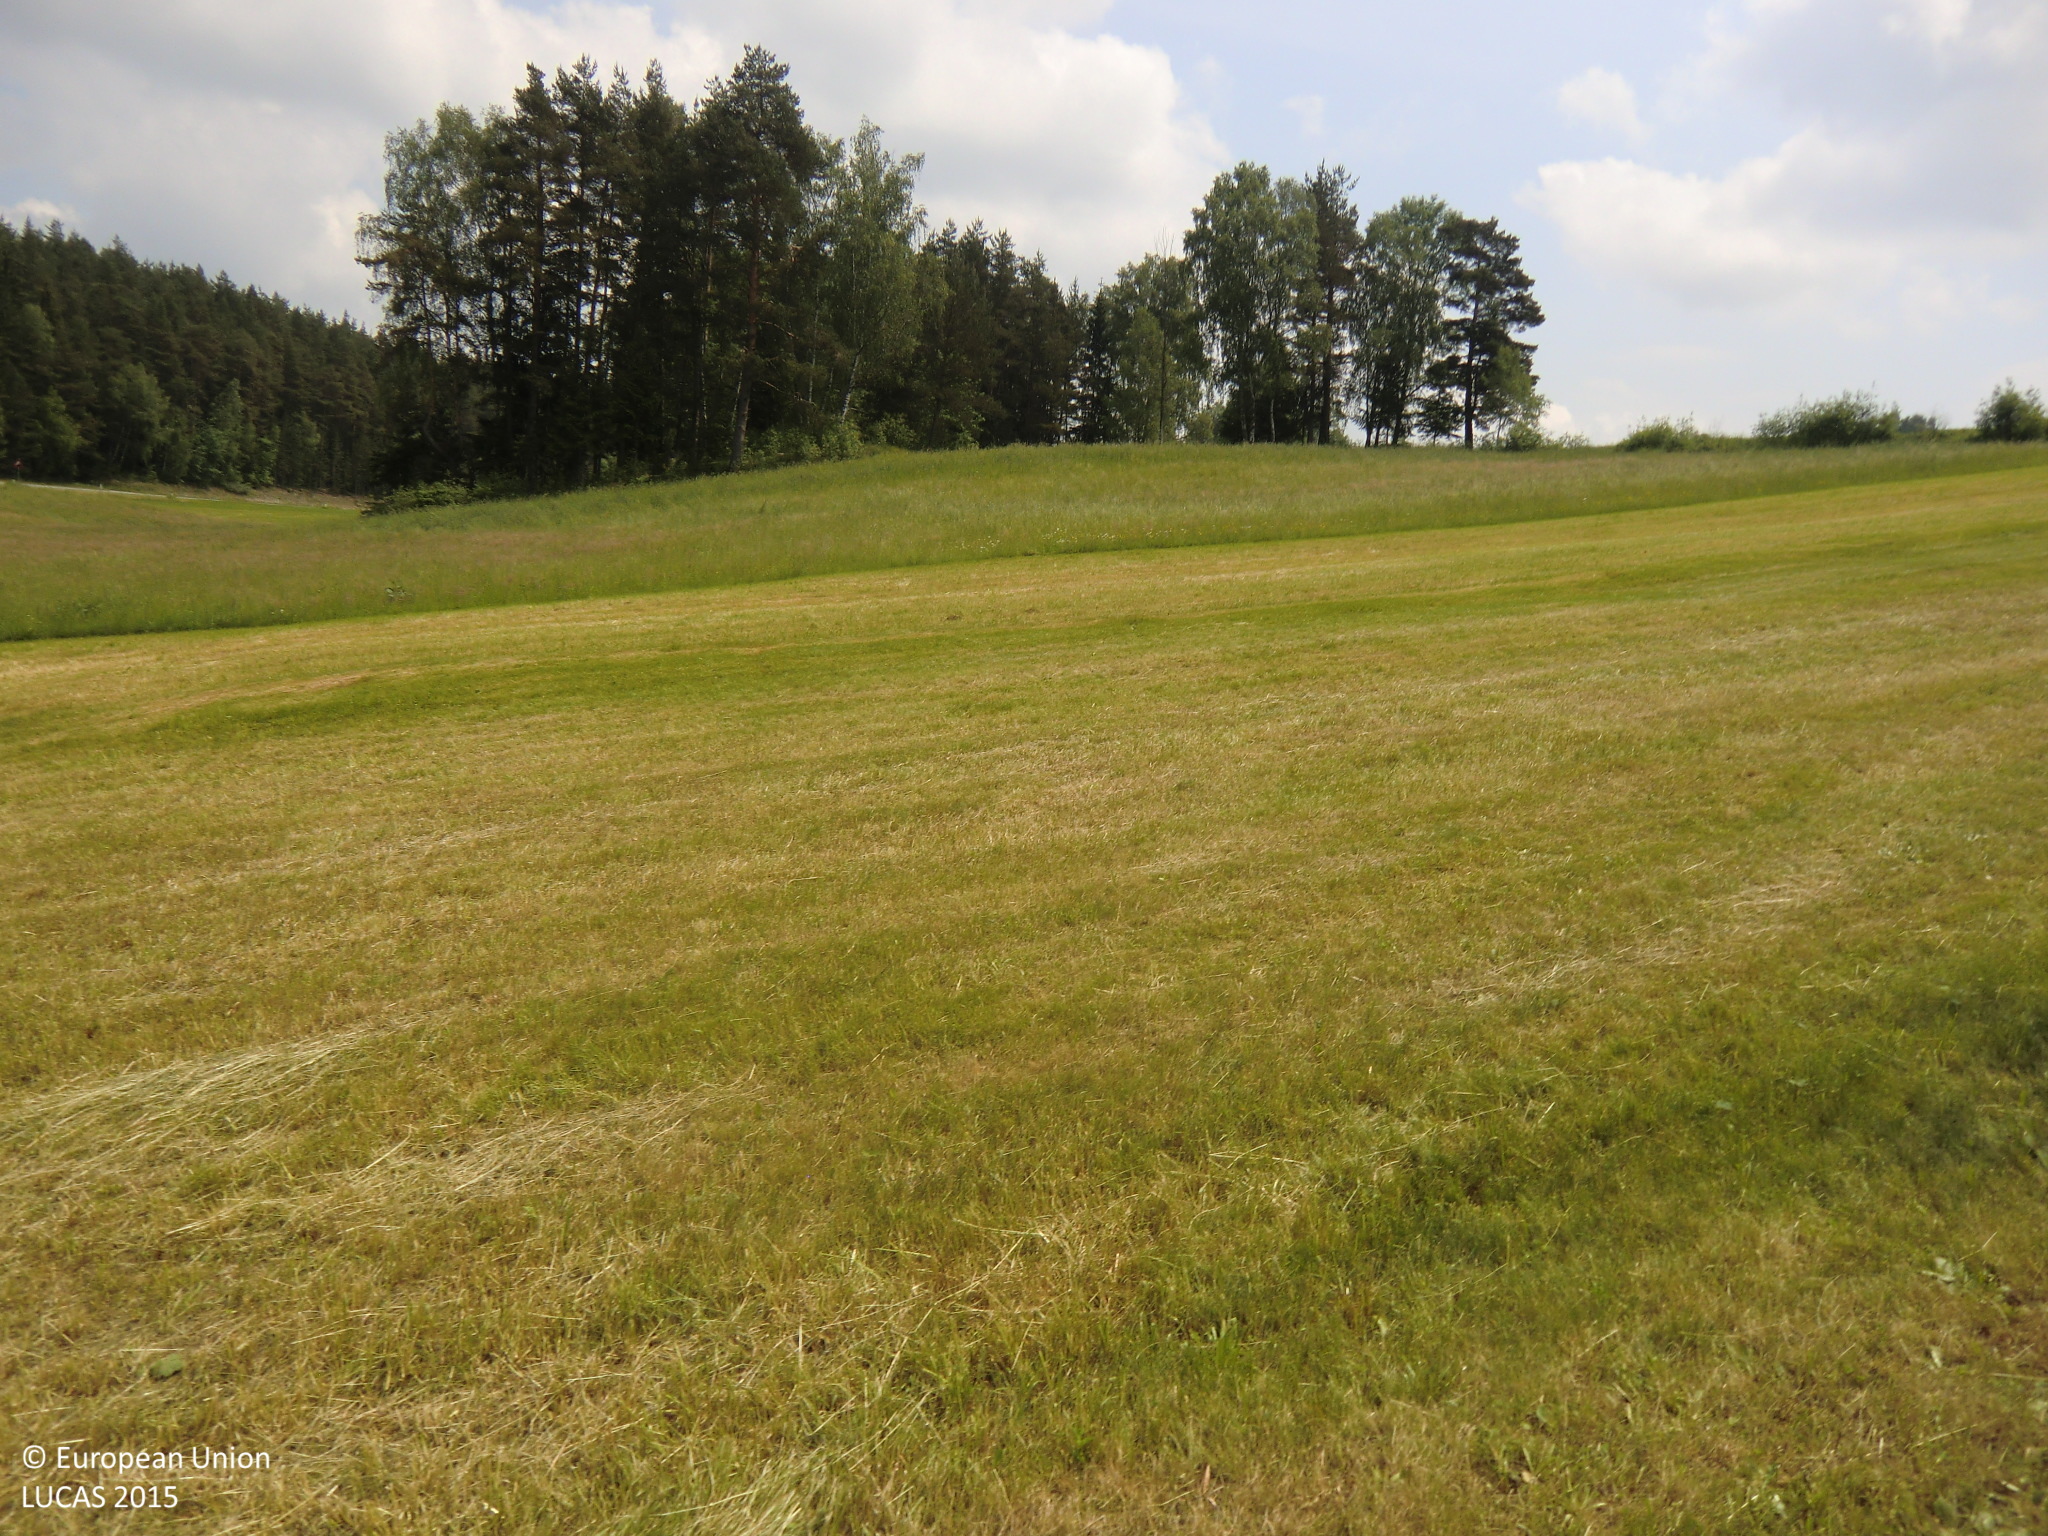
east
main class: Grassland
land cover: Grassland without tree/shrub cover
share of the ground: > 75 %
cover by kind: herbaceous plants 100 %
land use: Agriculture (excluding fallow land and kitchen gardens)
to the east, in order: Grassland without tree/shrub cover; Other mixed woodland; Grassland without tree/shrub cover; Tracks; Spruce dominated mixed woodland; Grassland without tree/shrub cover
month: June
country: AT
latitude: 48.6386
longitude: 14.8734
